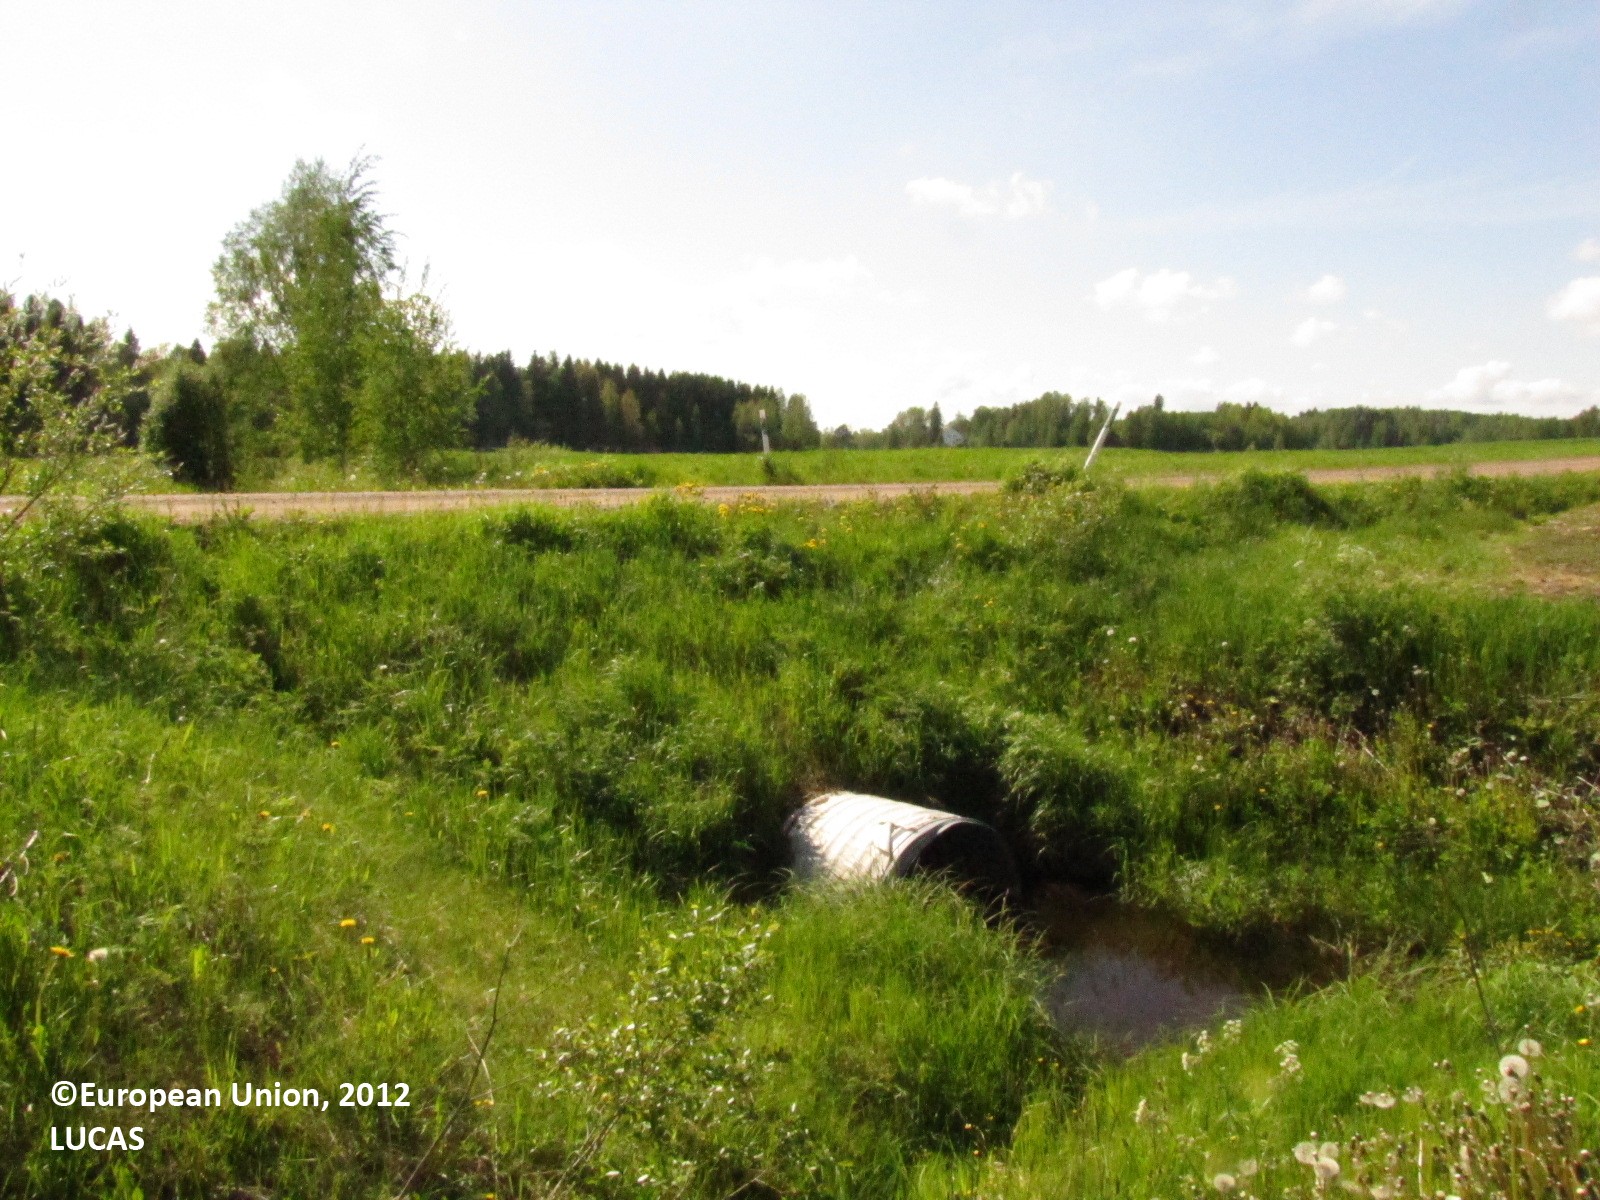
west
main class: Cropland
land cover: Temporary grasslands
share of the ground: > 75 %
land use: Agriculture (excluding fallow land and kitchen gardens)
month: June
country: FI
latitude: 61.5592
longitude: 23.1164
